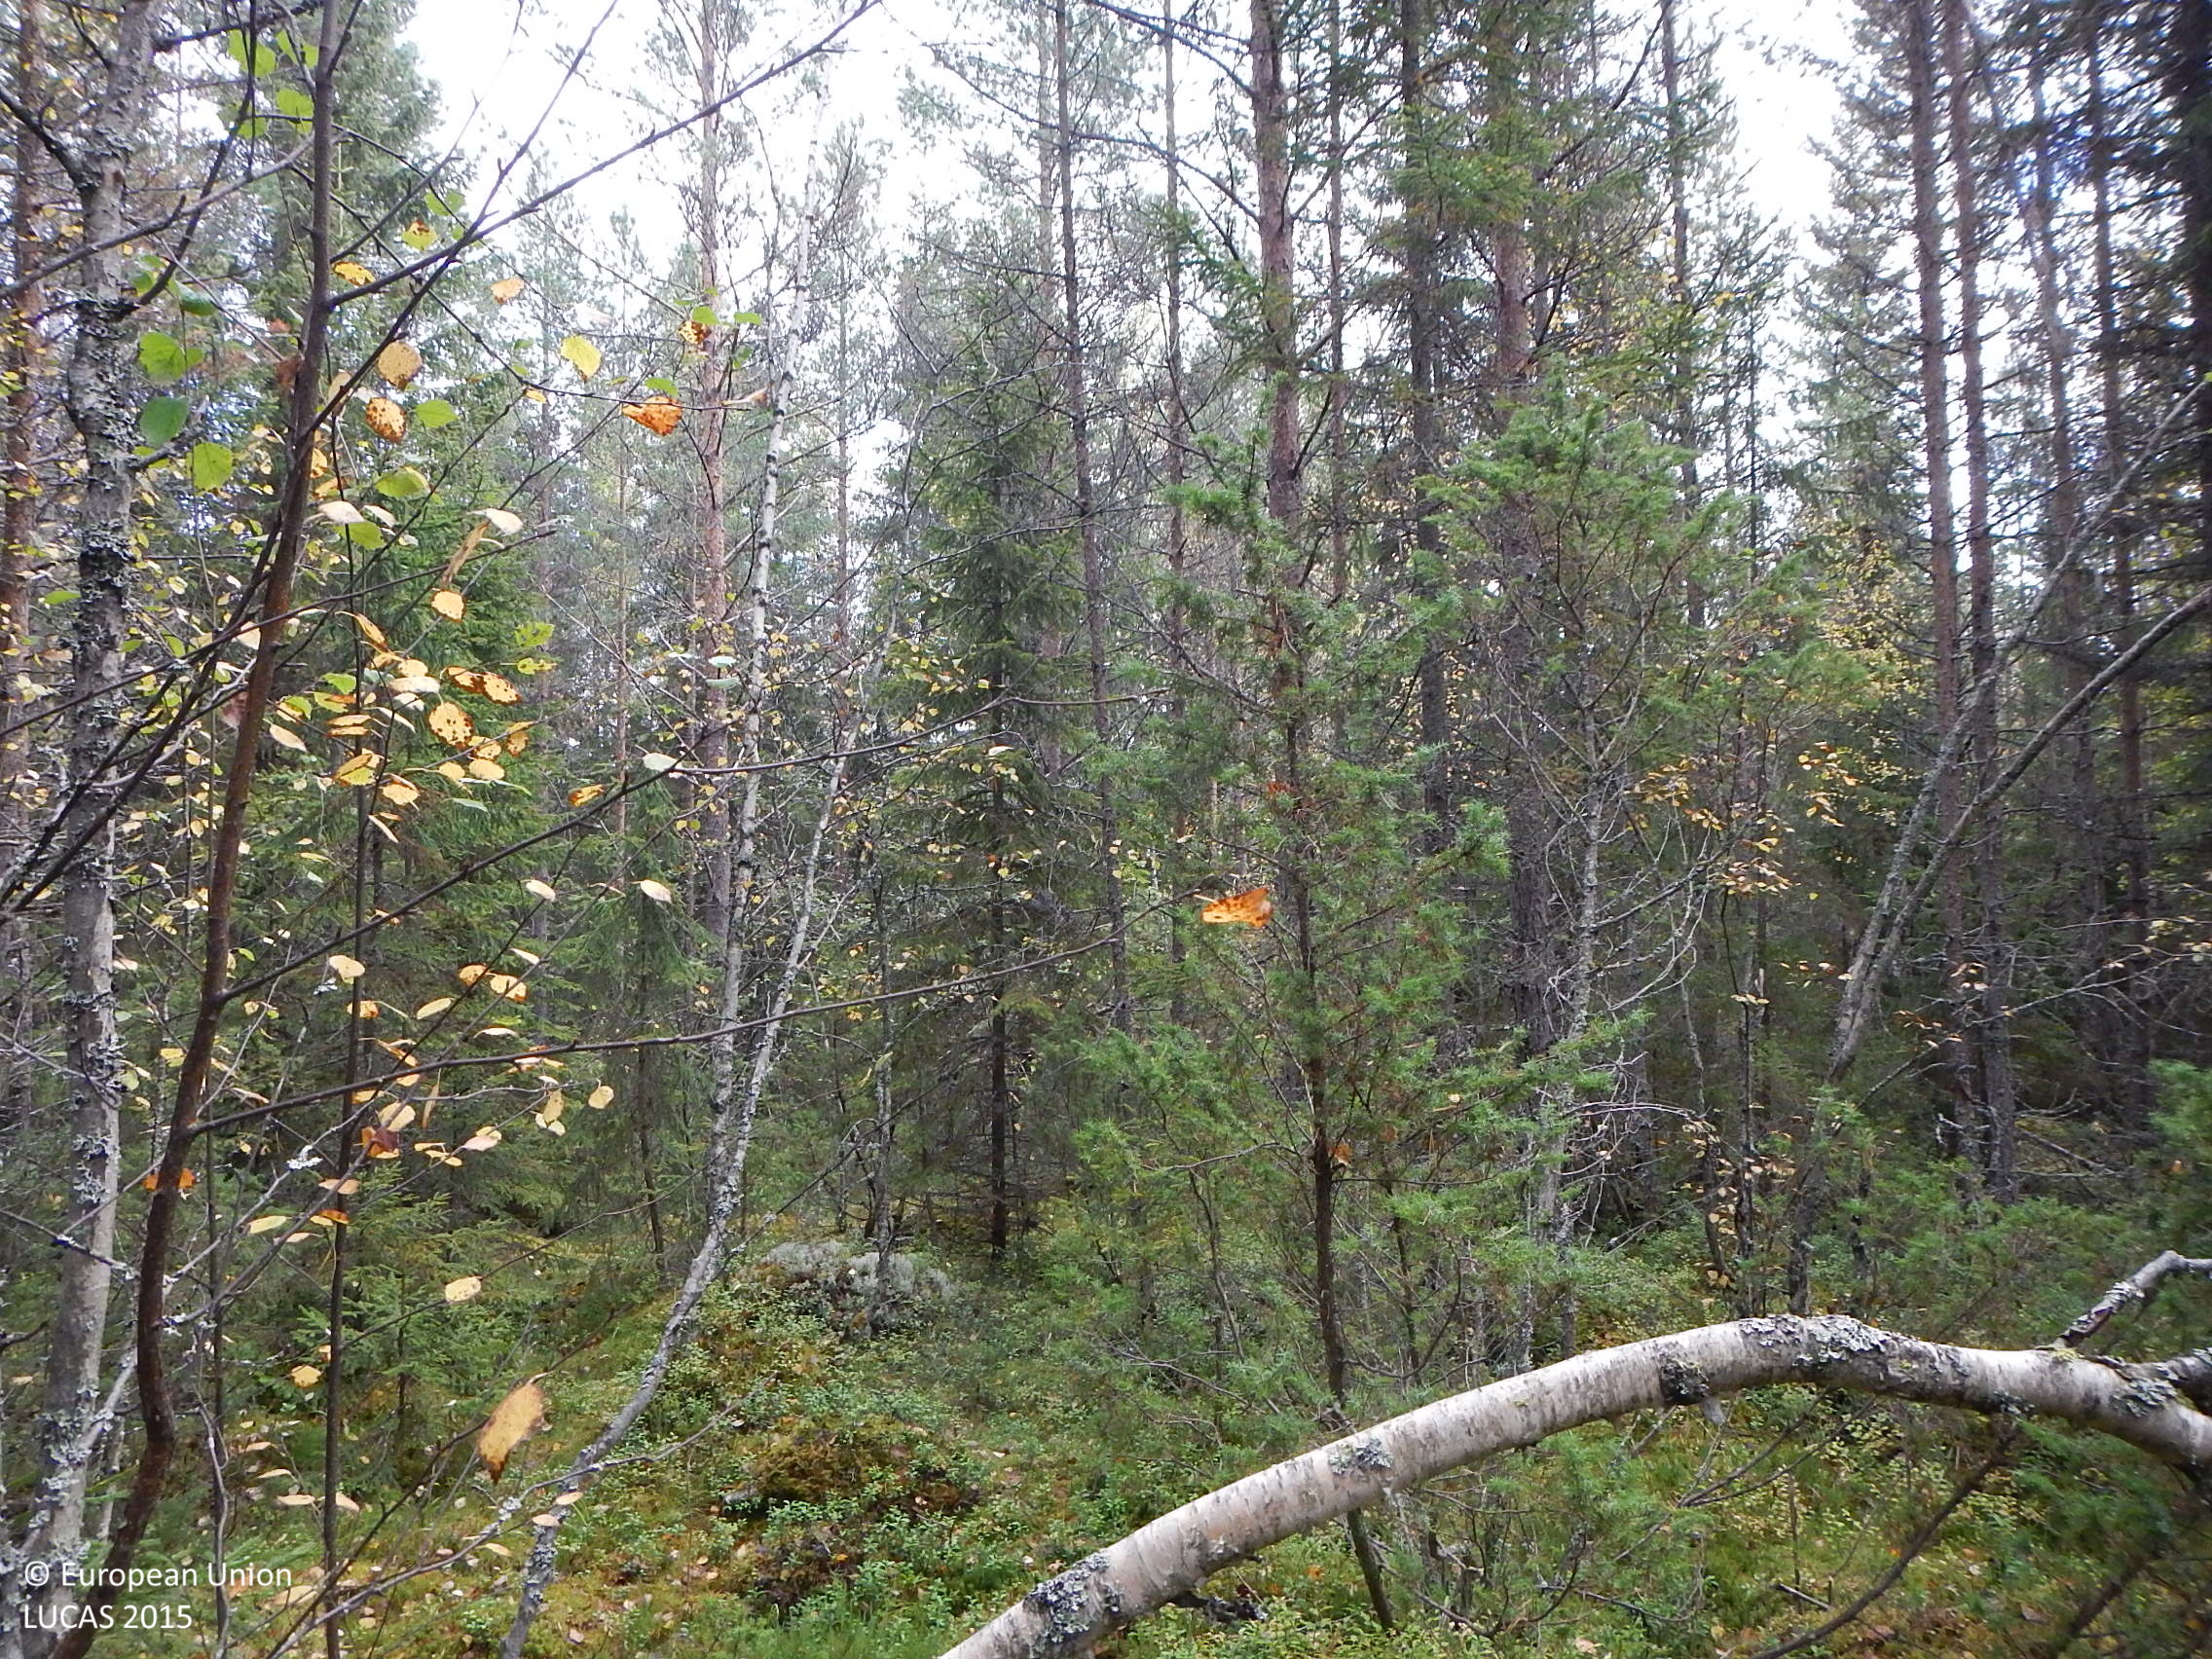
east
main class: Woodland
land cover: Other mixed woodland
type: boreal forest
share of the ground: 50 - 75 %
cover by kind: coniferous forest trees 40 %, broadleaved forest trees 25 %, shrubs 20 %, lichens and mosses 10 %, herbaceous plants 5 %
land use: Forestry
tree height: > 5 m
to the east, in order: Other mixed woodland; Ditches and canals; Other coniferous woodland; Other mixed woodland; Ditches and canals; Pine dominated mixed woodland
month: September
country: FI
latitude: 62.0016
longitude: 22.8778
